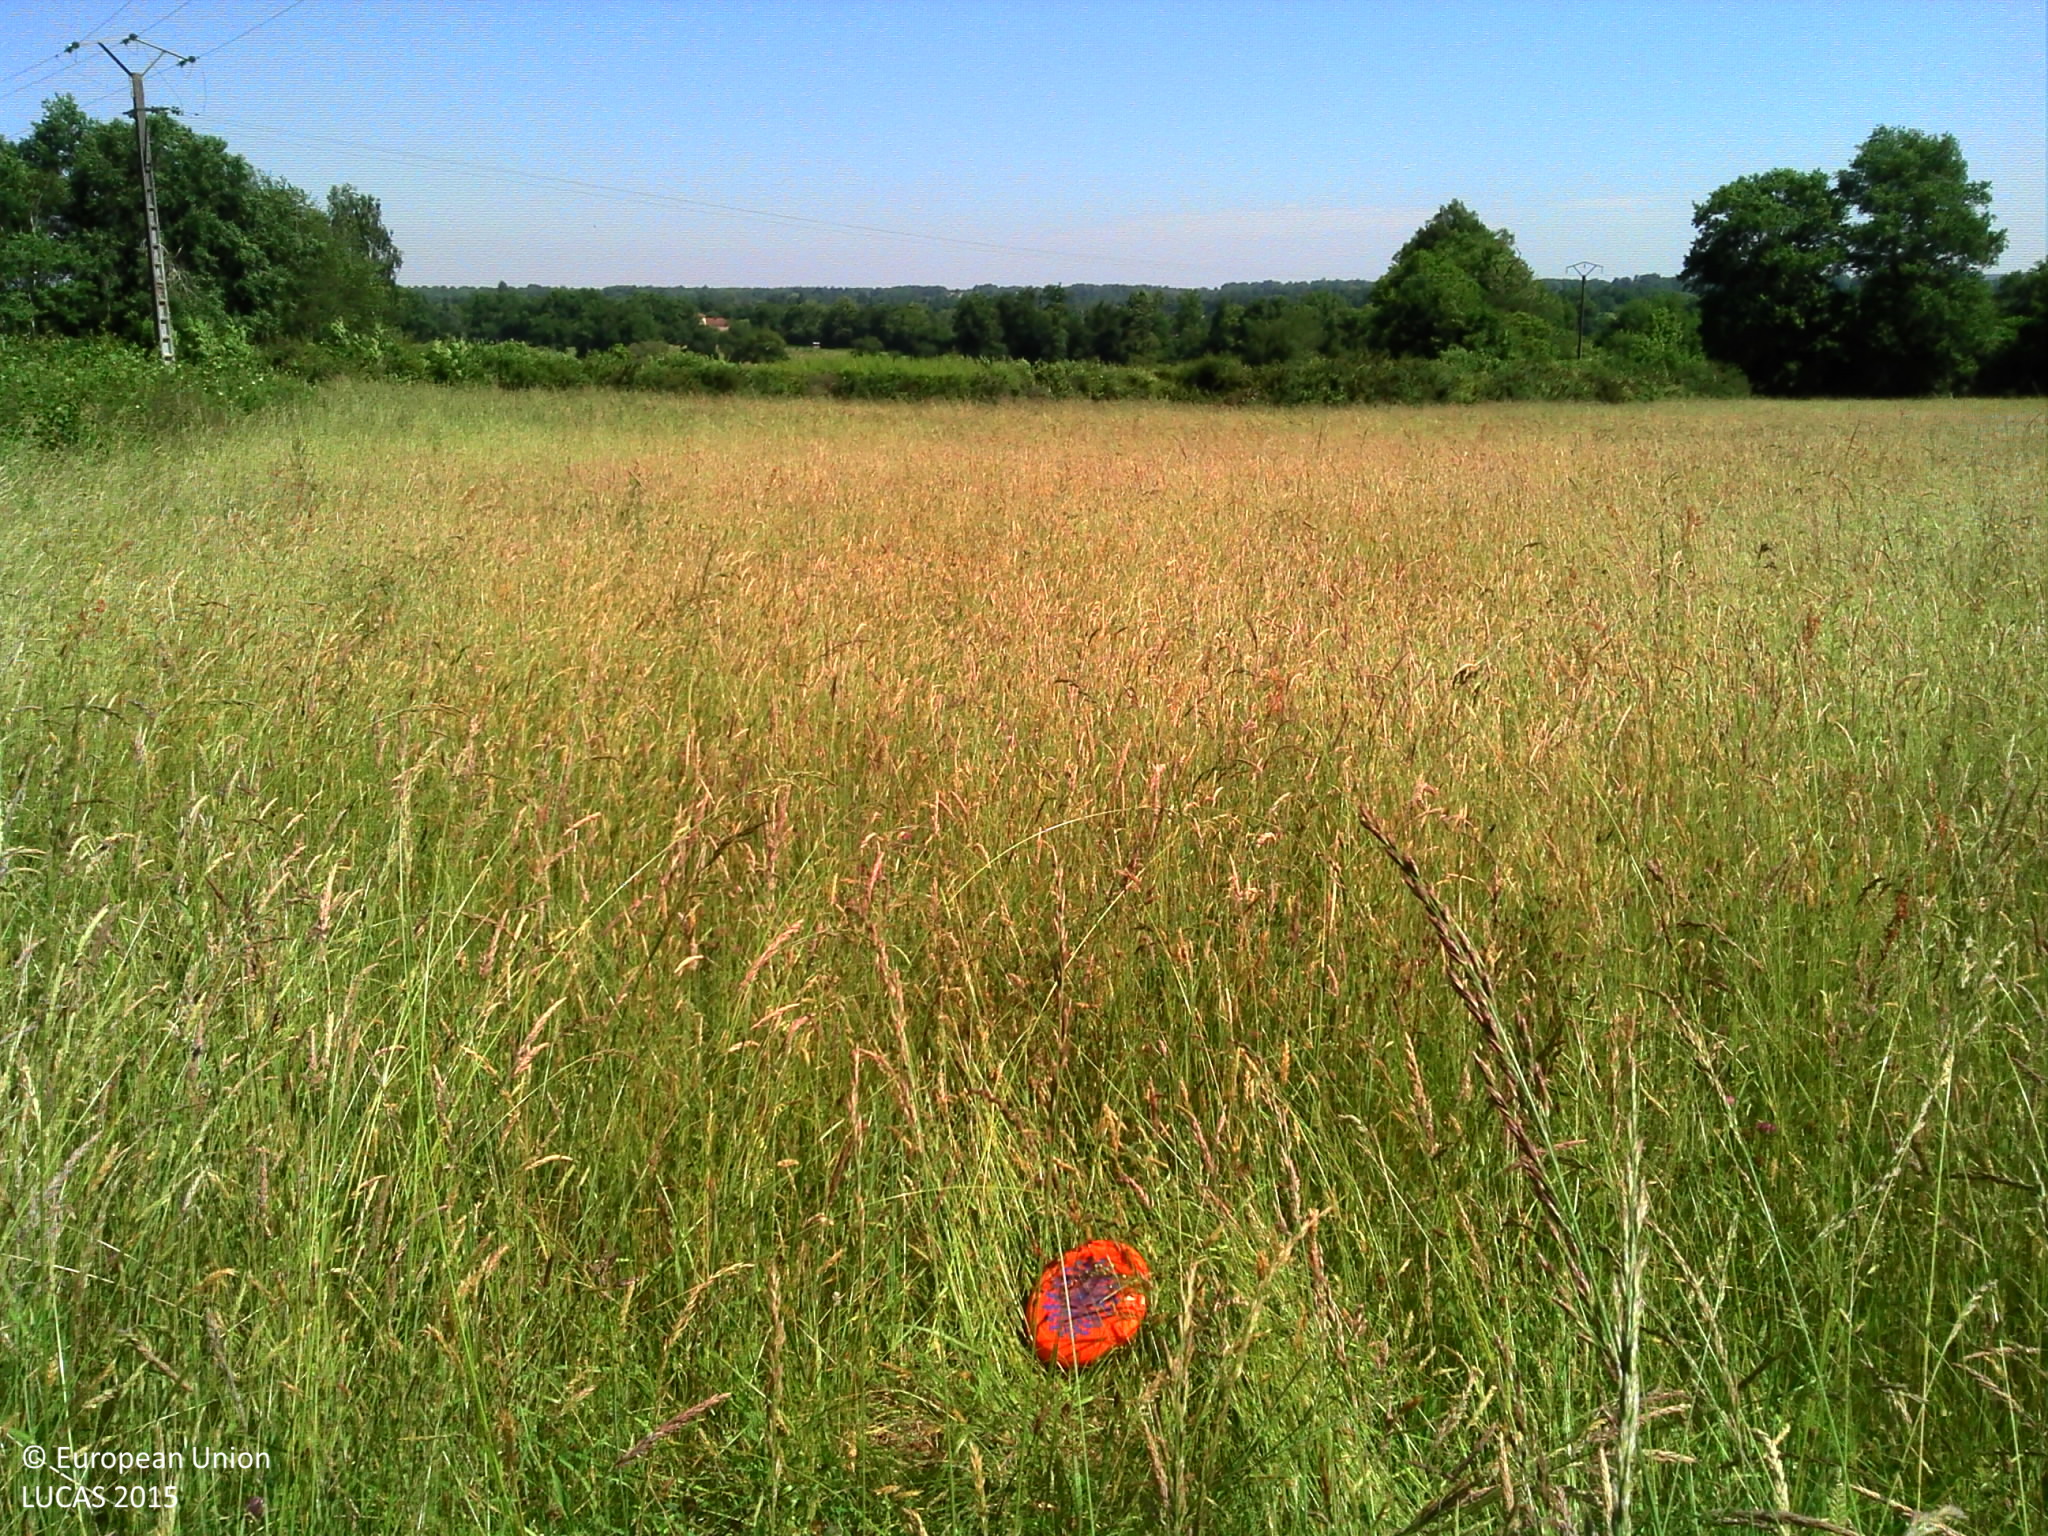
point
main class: Grassland
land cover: Grassland without tree/shrub cover
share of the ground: > 75 %
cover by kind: herbaceous plants 100 %
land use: Agriculture (excluding fallow land and kitchen gardens)
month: June
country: FR
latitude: 46.0310
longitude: 0.6448
